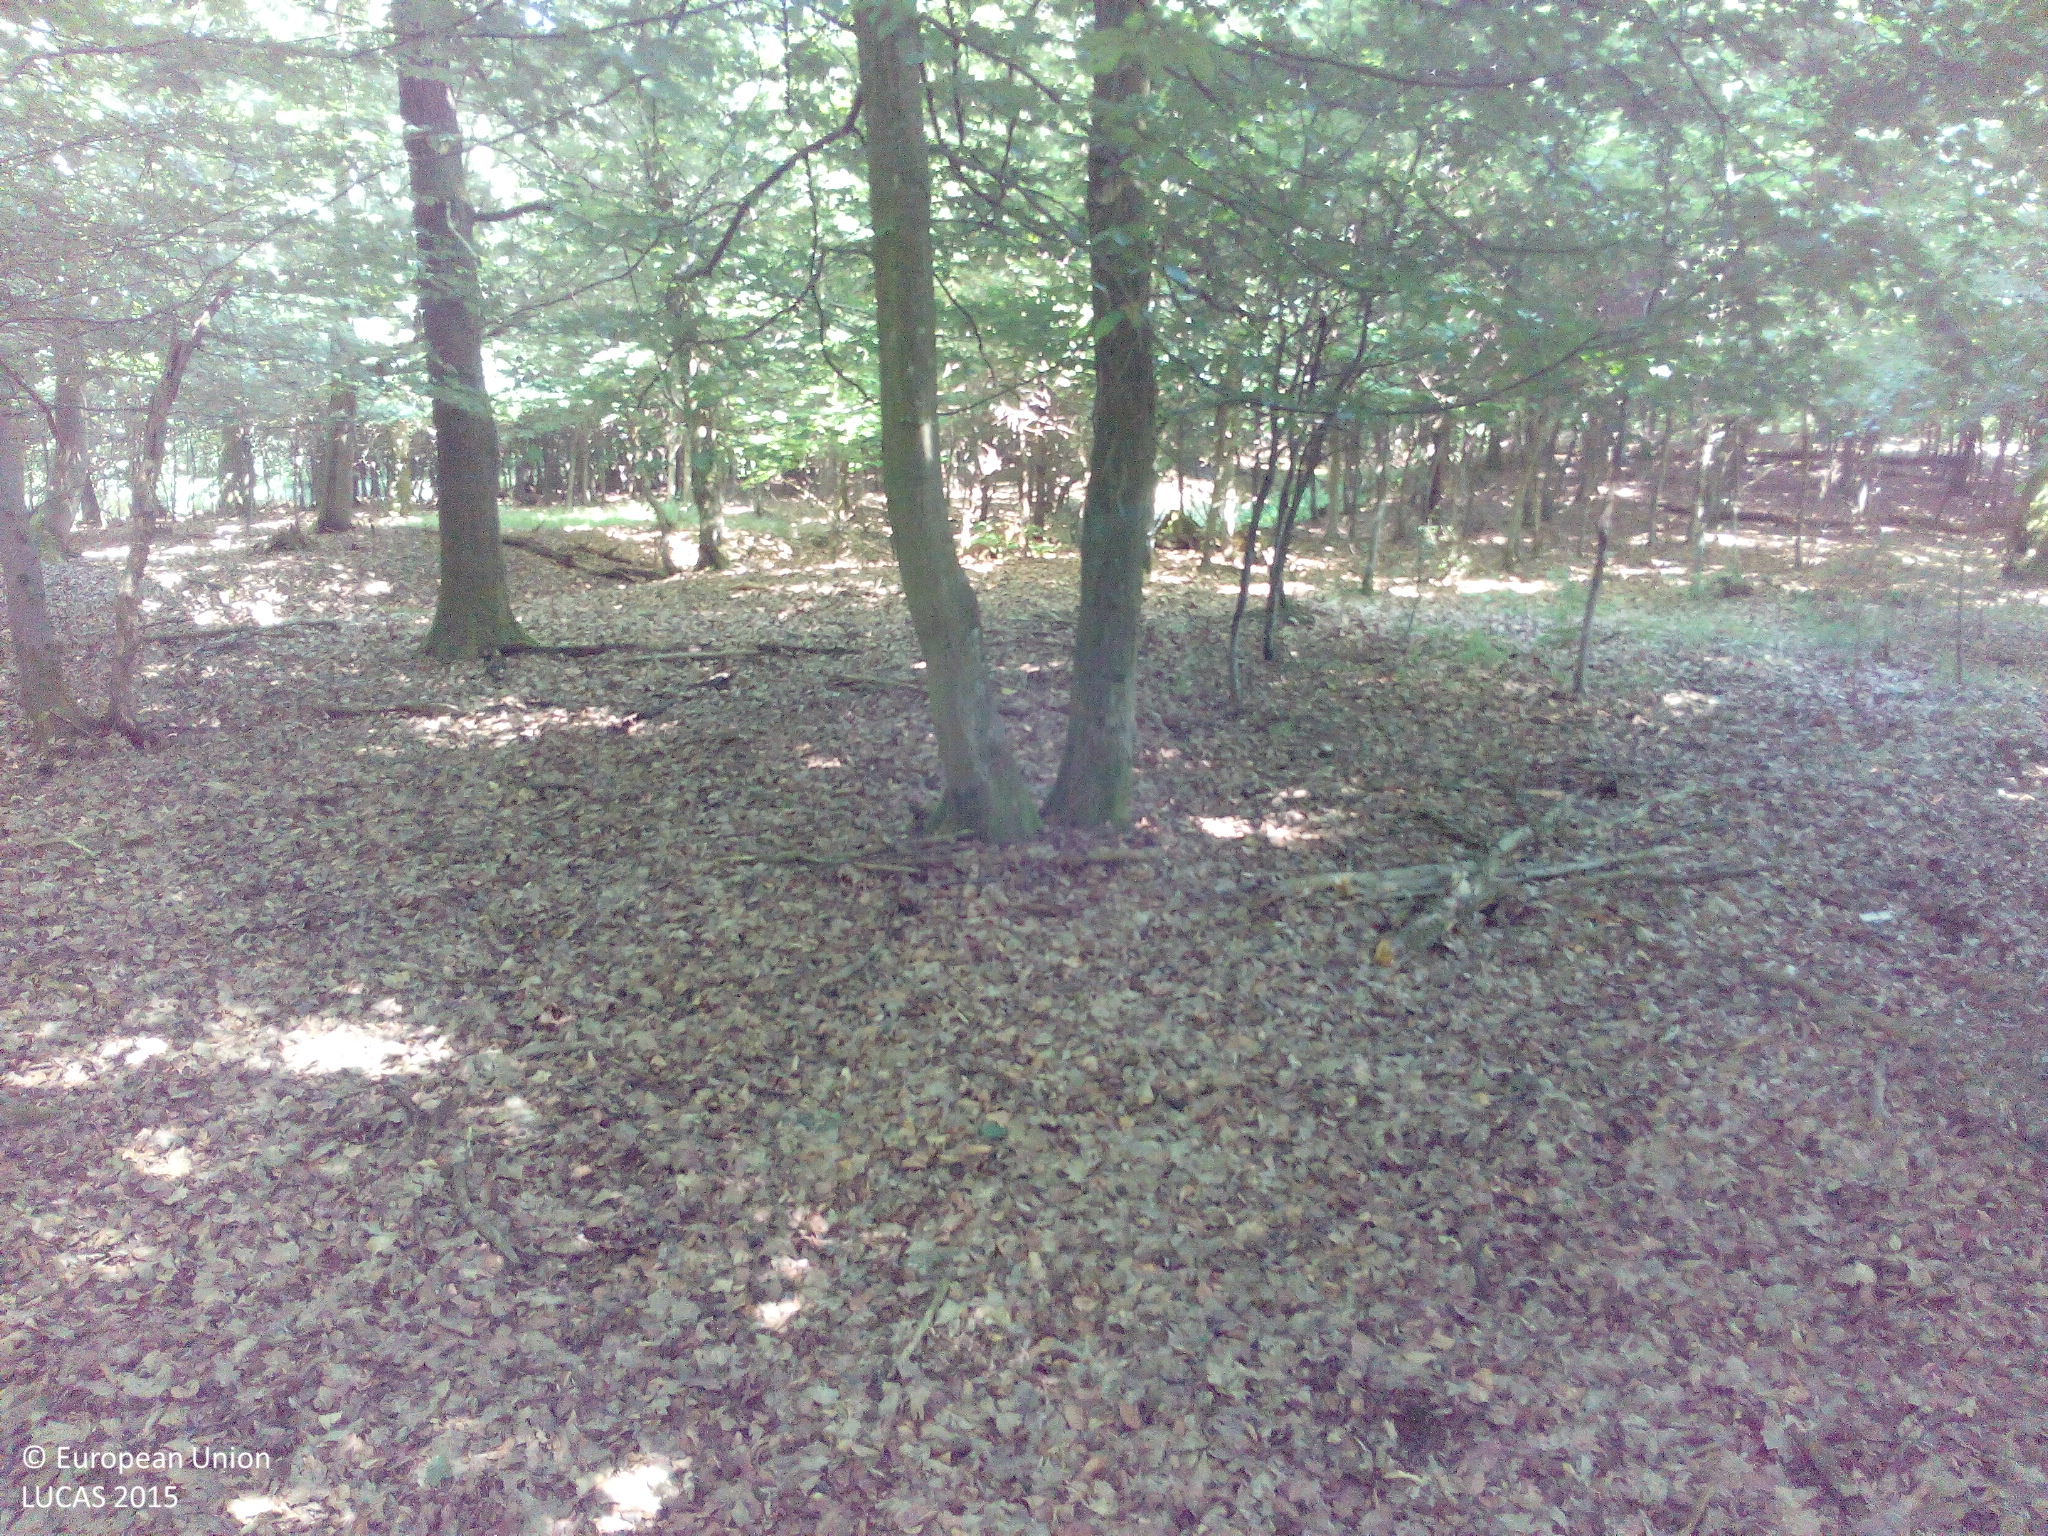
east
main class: Woodland
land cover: Broadleaved woodland
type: mesophytic deciduous forest
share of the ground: > 75 %
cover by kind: broadleaved forest trees 90 %, unconsolidated bare surface 10 %
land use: Forestry
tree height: > 5 m
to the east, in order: Broadleaved woodland; Tracks; Broadleaved woodland; Tracks; Broadleaved woodland
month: June
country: DE
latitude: 50.1851
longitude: 8.0257
